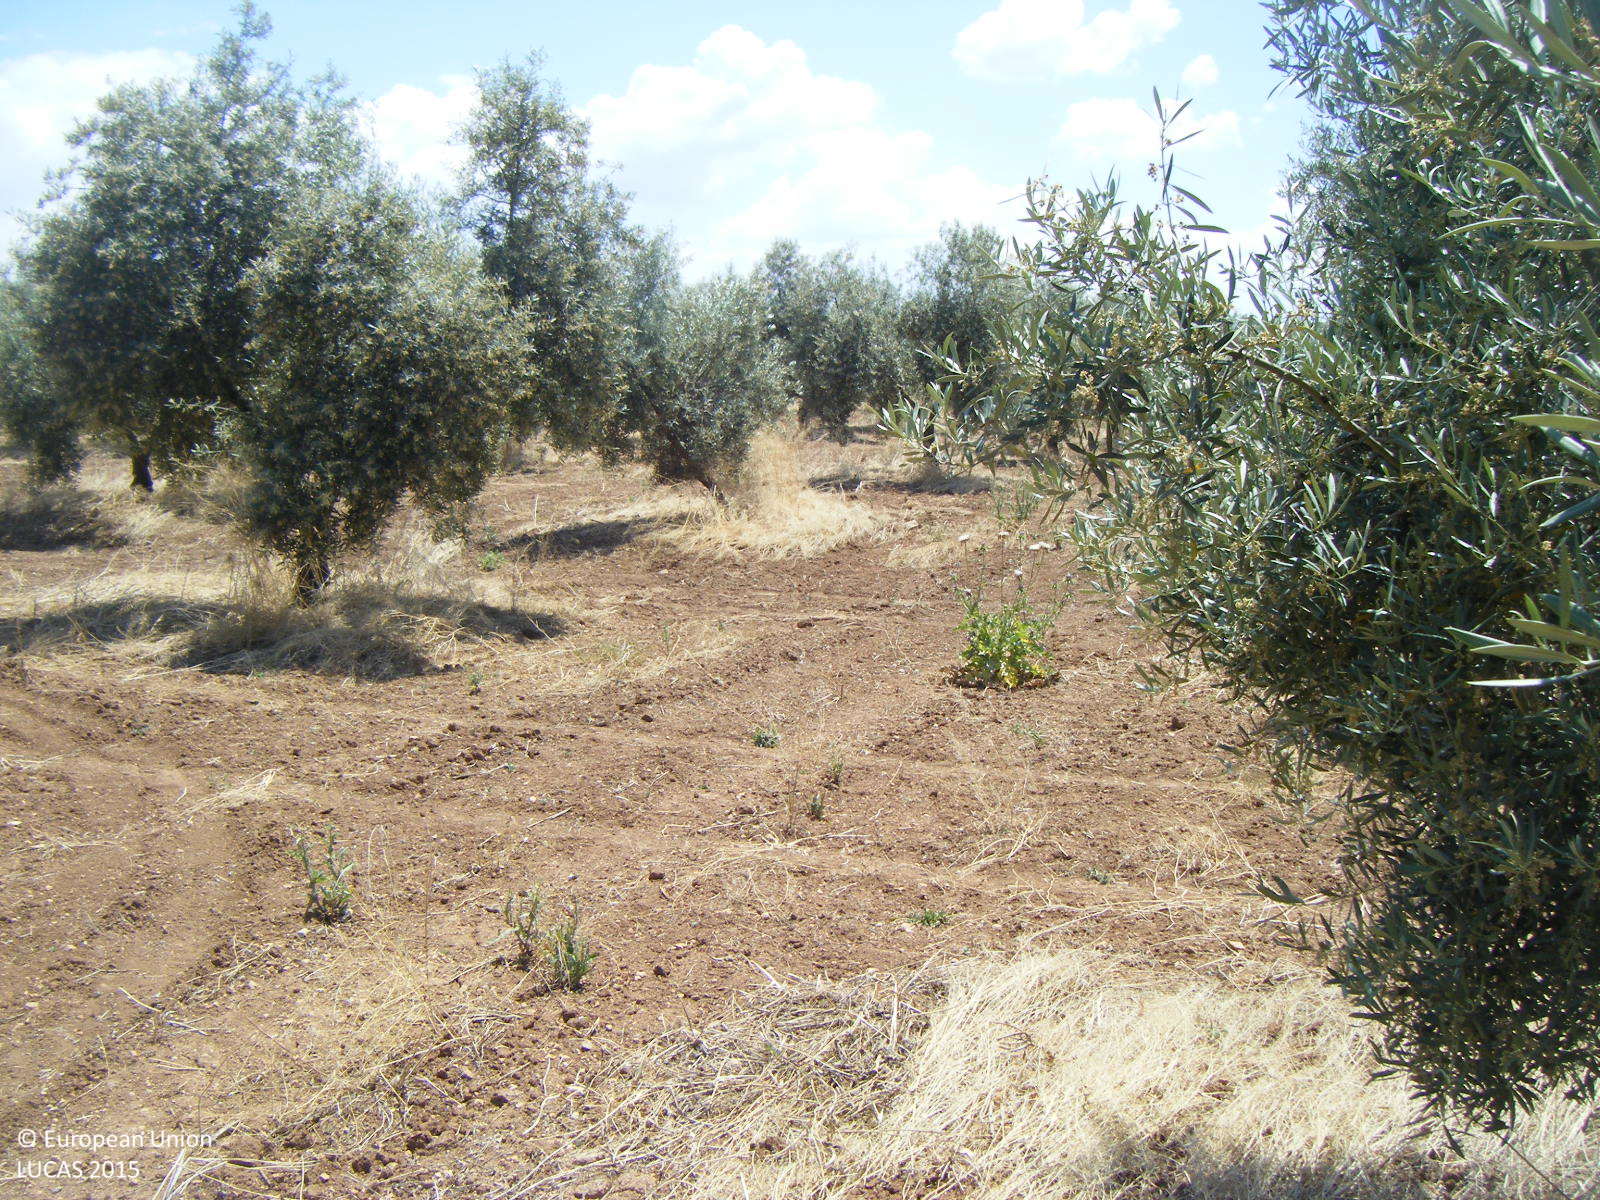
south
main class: Cropland
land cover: Olive groves
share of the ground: 10 - 25 %
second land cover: Other bare soil
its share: > 75 %
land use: Agriculture (excluding fallow land and kitchen gardens)
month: May
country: ES
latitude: 37.1788
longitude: -4.5176
